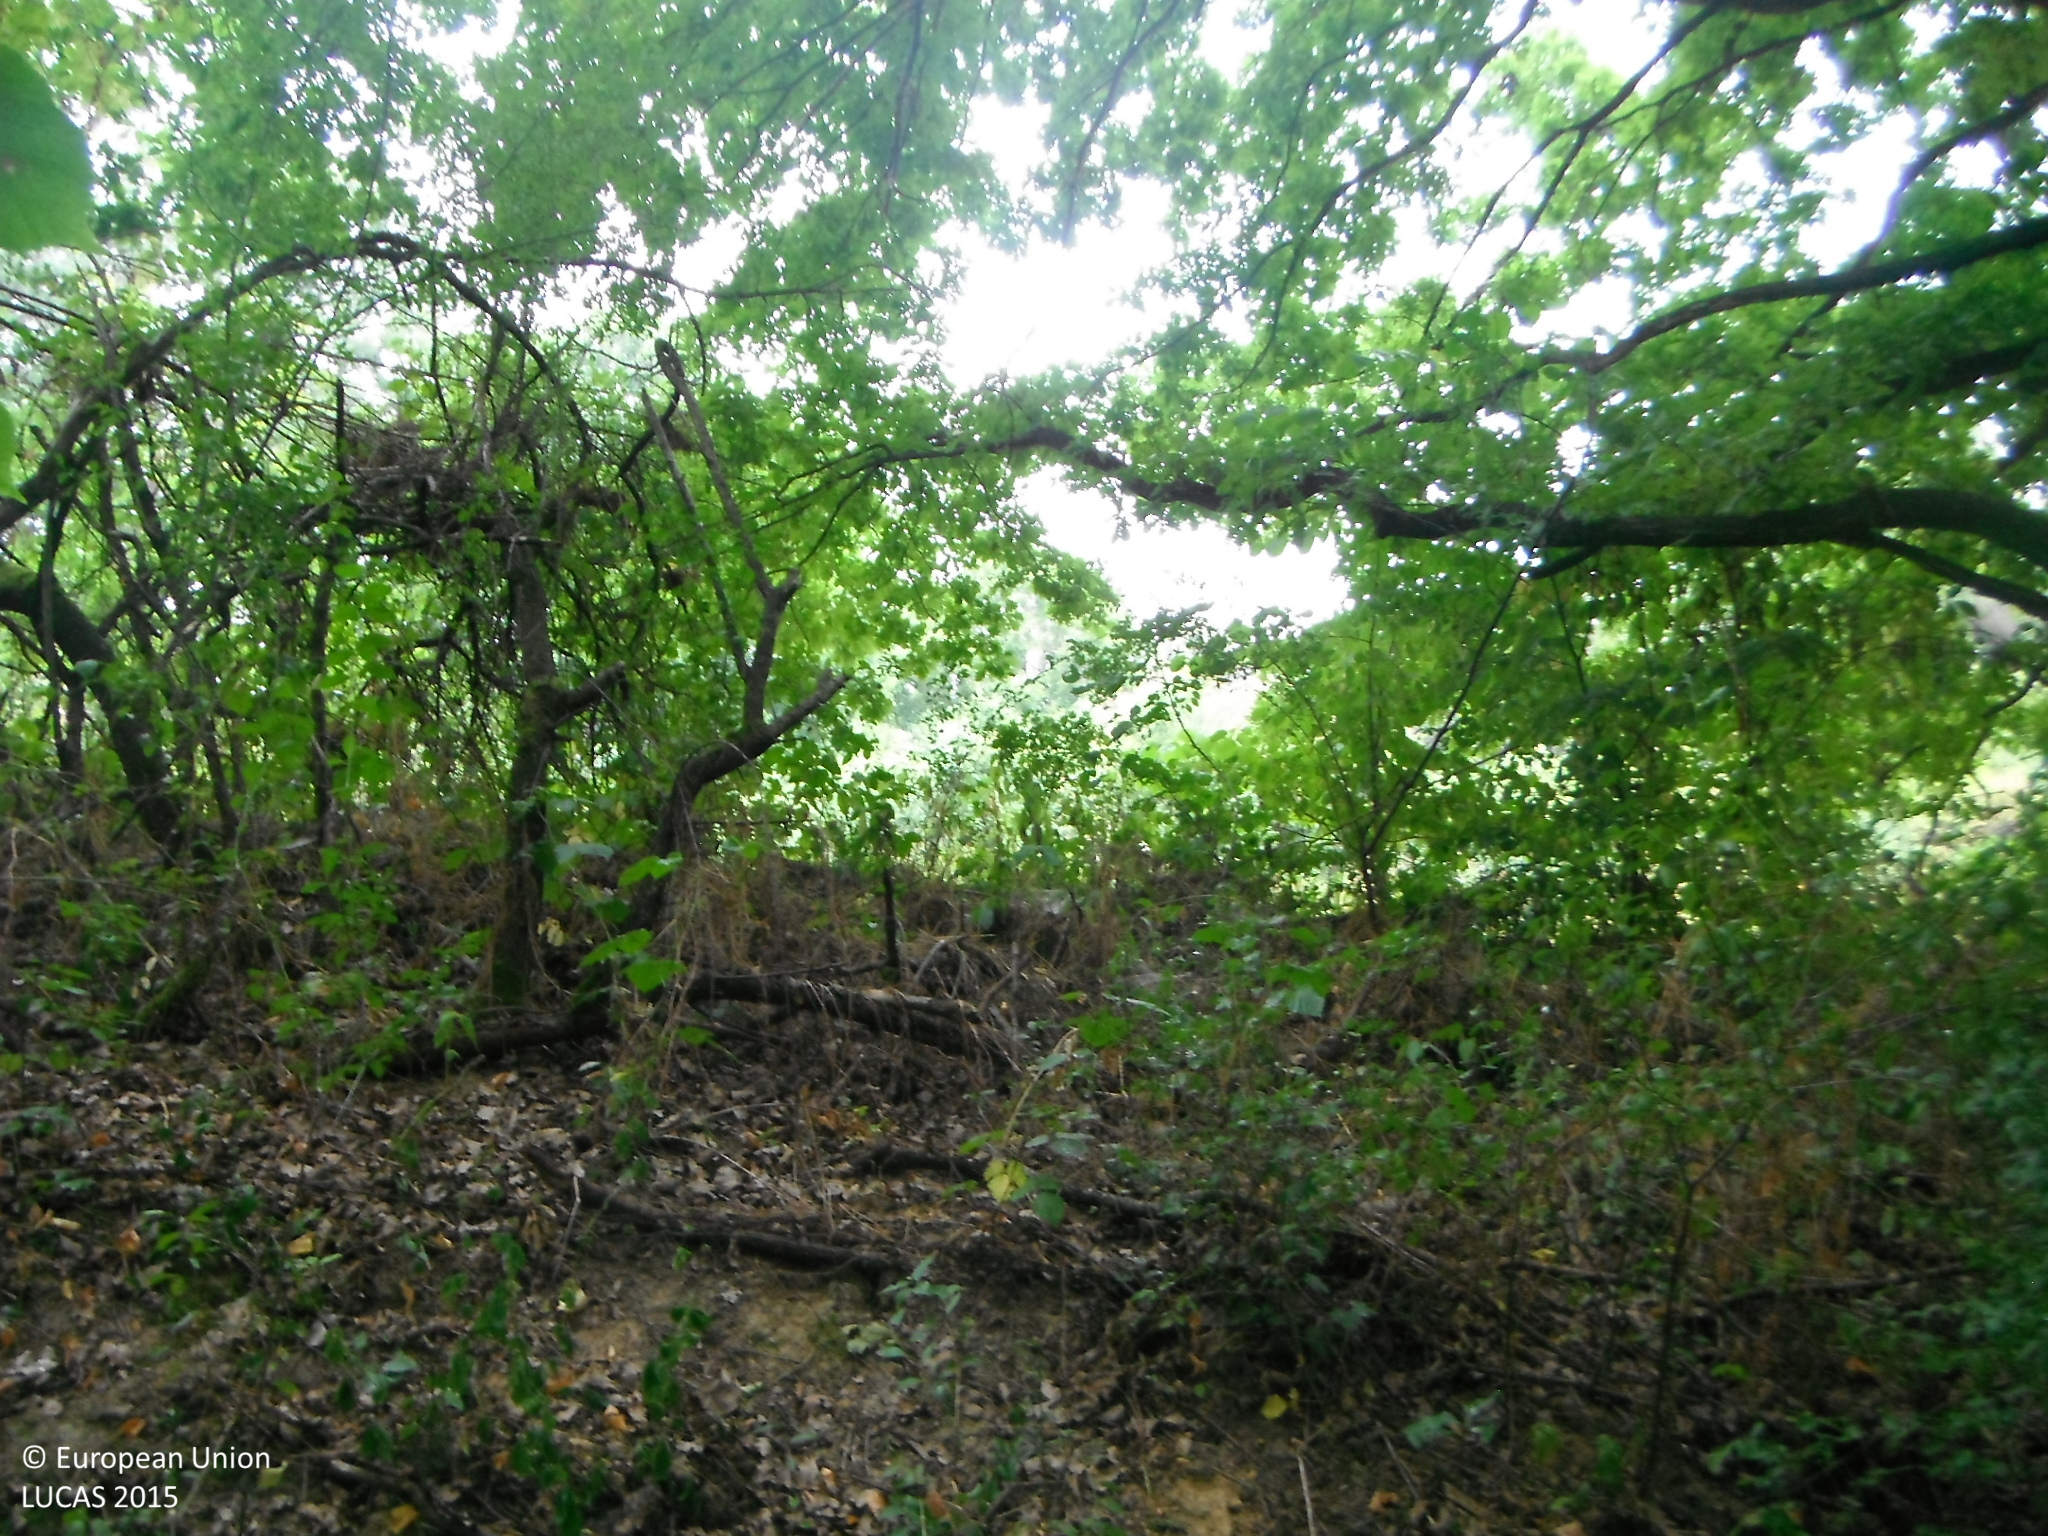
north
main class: Woodland
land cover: Broadleaved woodland
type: mesophytic deciduous forest
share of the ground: > 75 %
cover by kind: broadleaved forest trees 80 %, herbaceous plants 20 %
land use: Forestry
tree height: > 5 m
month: July
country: SK
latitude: 48.6809
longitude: 18.1505
